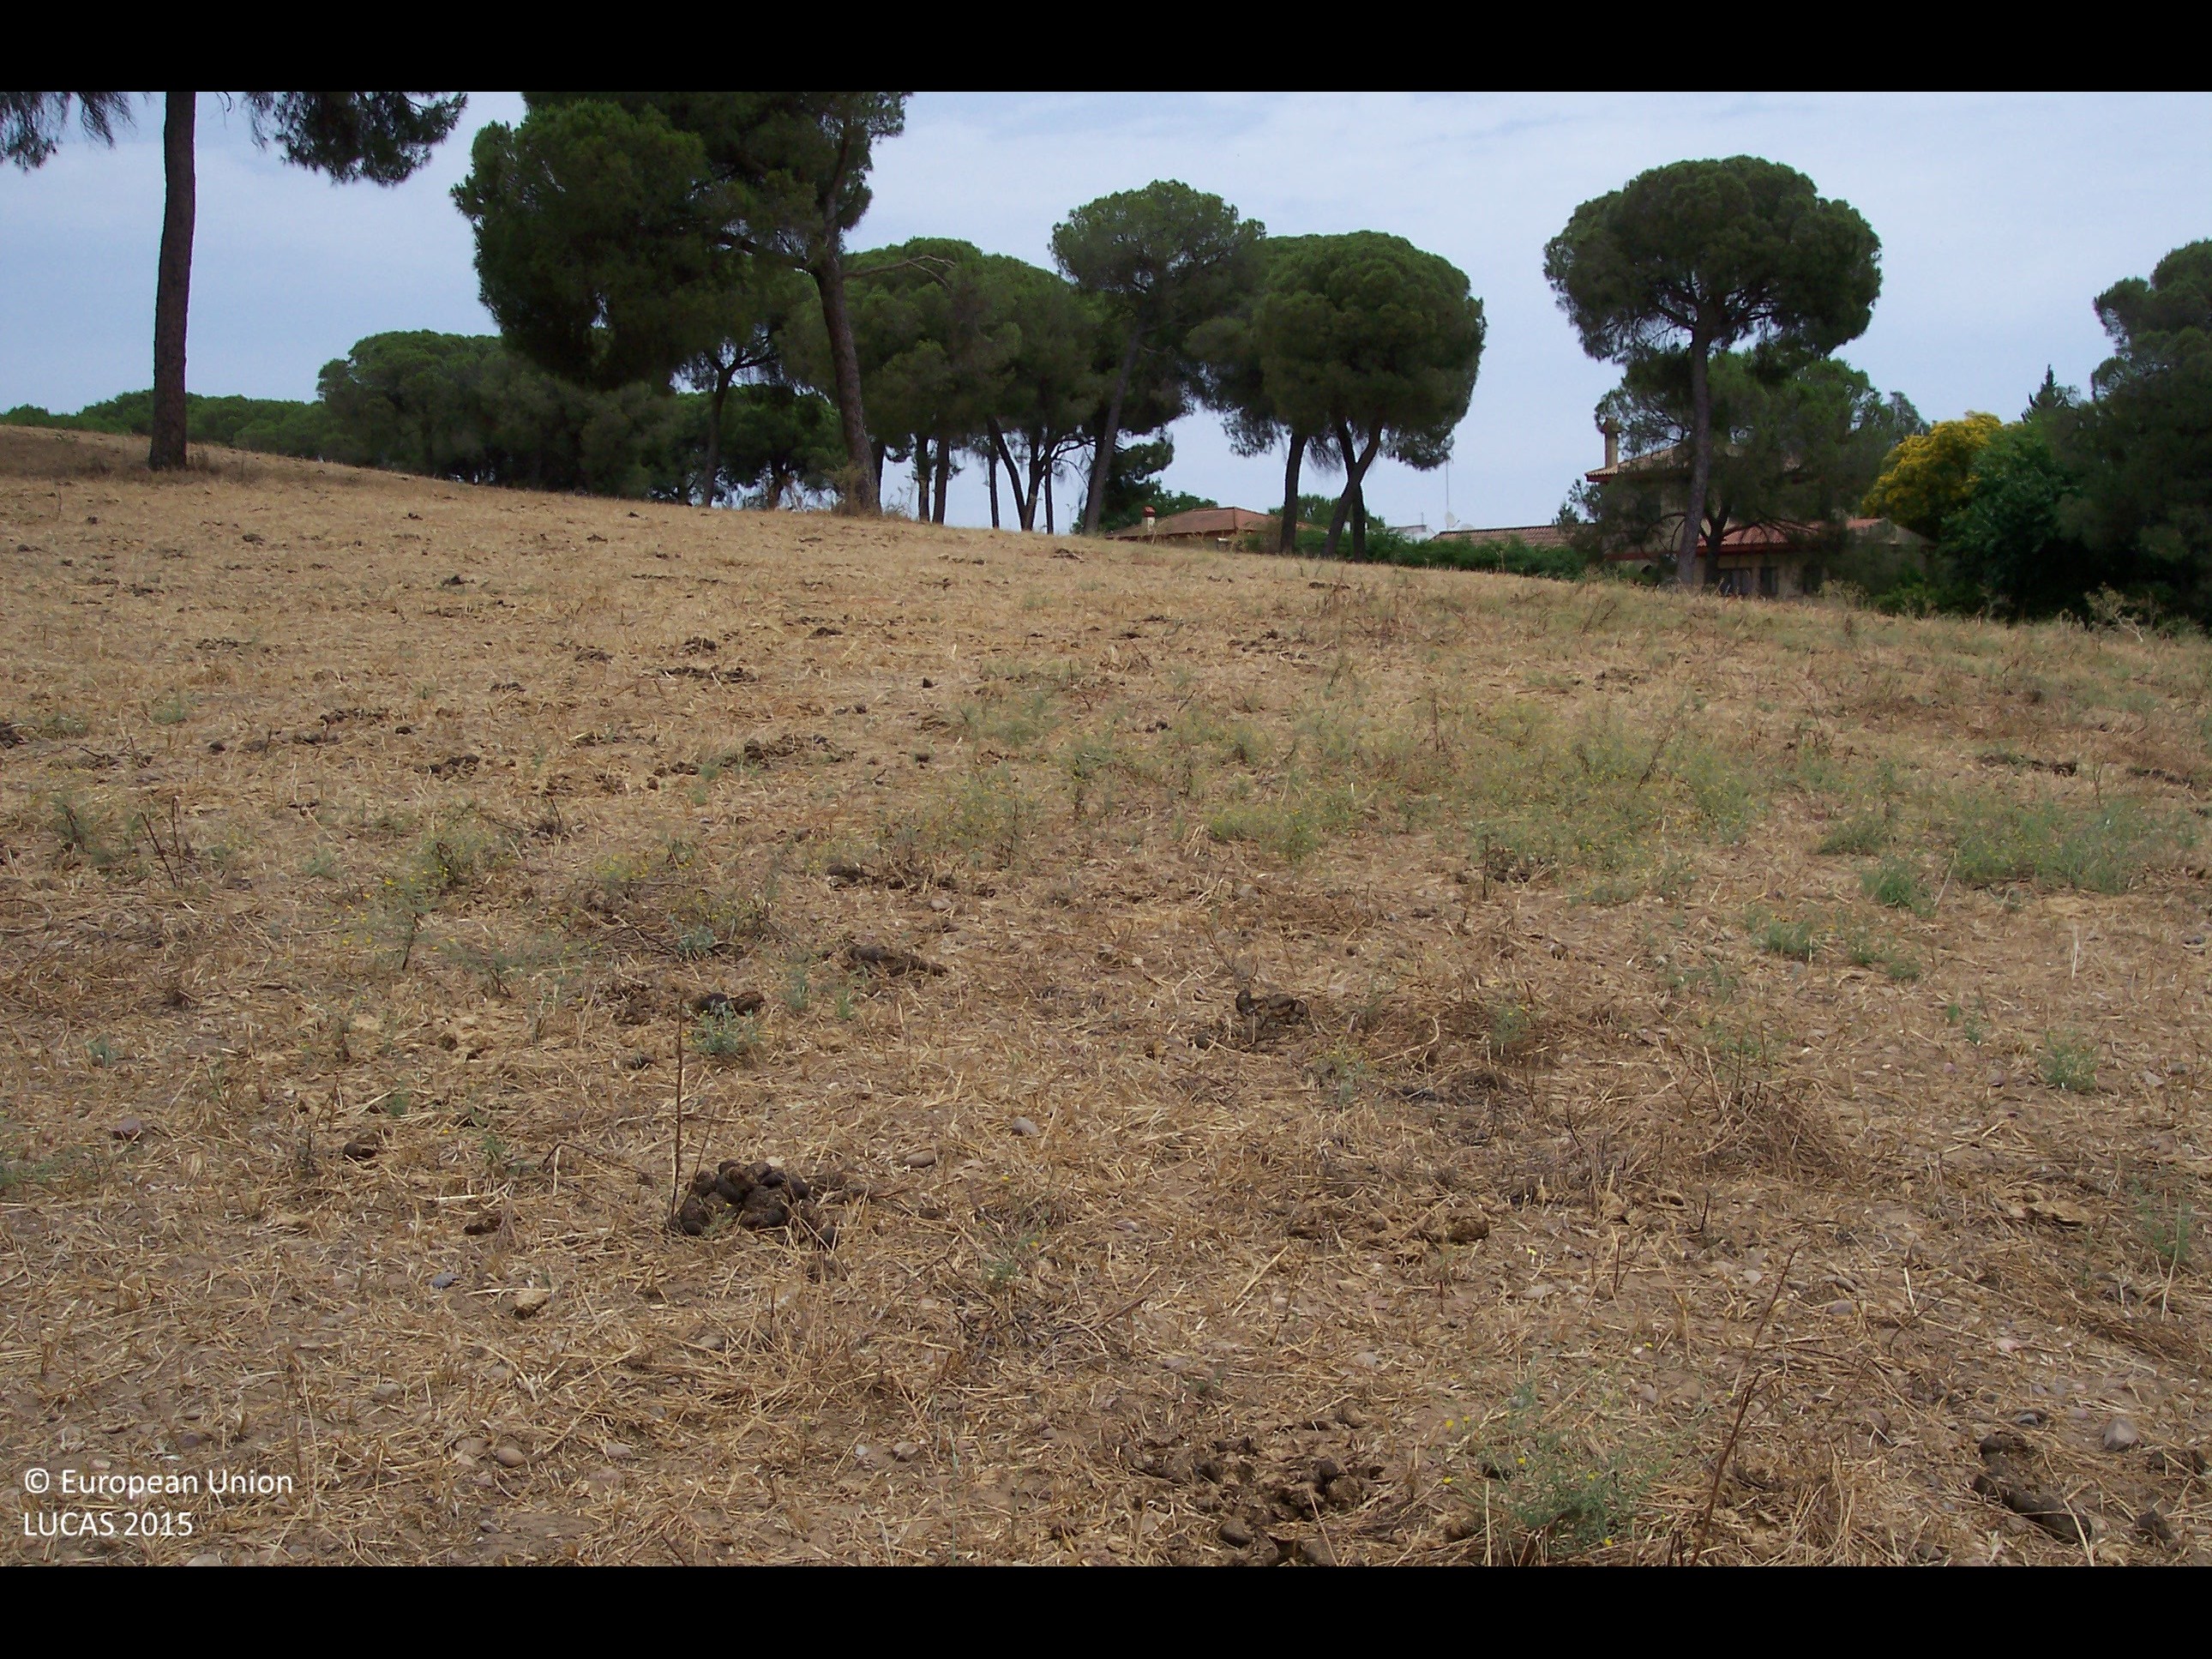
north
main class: Woodland
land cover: Pine dominated coniferous woodland
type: coniferous forest of the mediterranean region
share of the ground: 10 - 25 %
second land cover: Grassland without tree/shrub cover
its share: 50 - 75 %
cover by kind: herbaceous plants 90 %, coniferous forest trees 10 %
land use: Forestry
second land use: Agriculture (excluding fallow land and kitchen gardens)
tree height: > 5 m
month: June
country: ES
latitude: 37.2747
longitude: -6.0710
